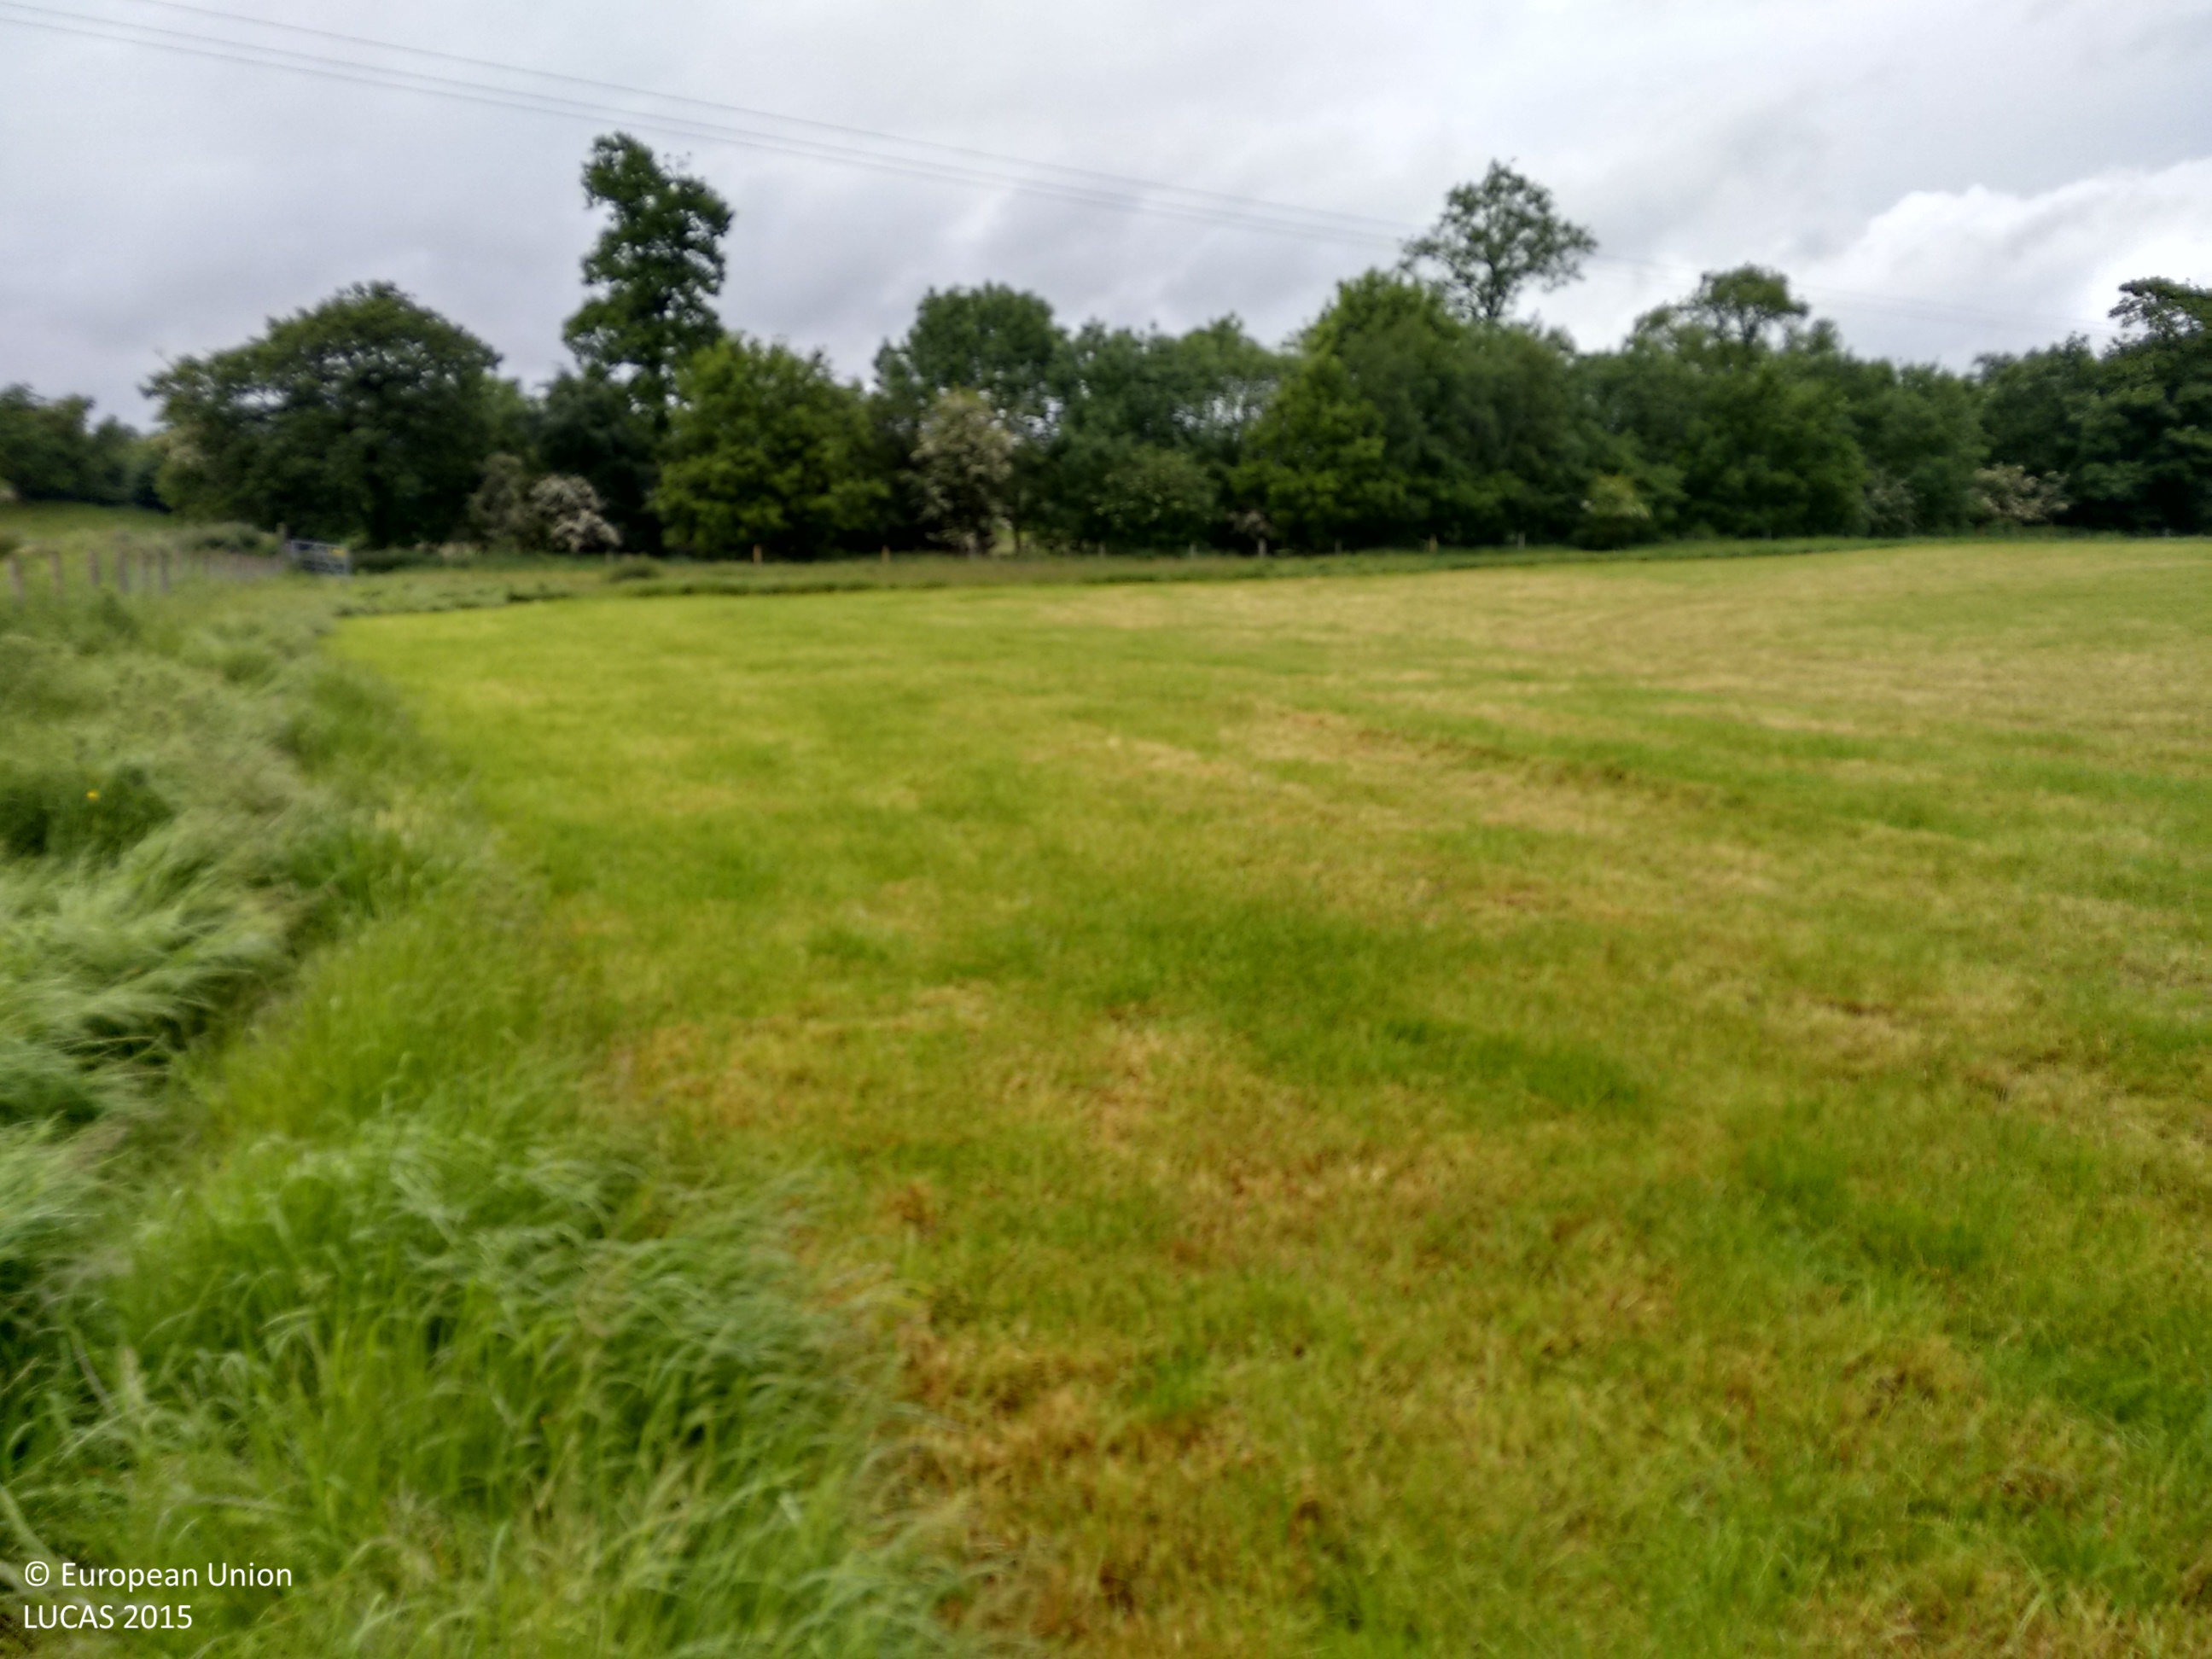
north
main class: Grassland
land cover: Grassland without tree/shrub cover
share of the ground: > 75 %
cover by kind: herbaceous plants 90 %, unconsolidated bare surface 10 %
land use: Agriculture (excluding fallow land and kitchen gardens)
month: June
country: GB
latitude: 55.1596
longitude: -3.4997
